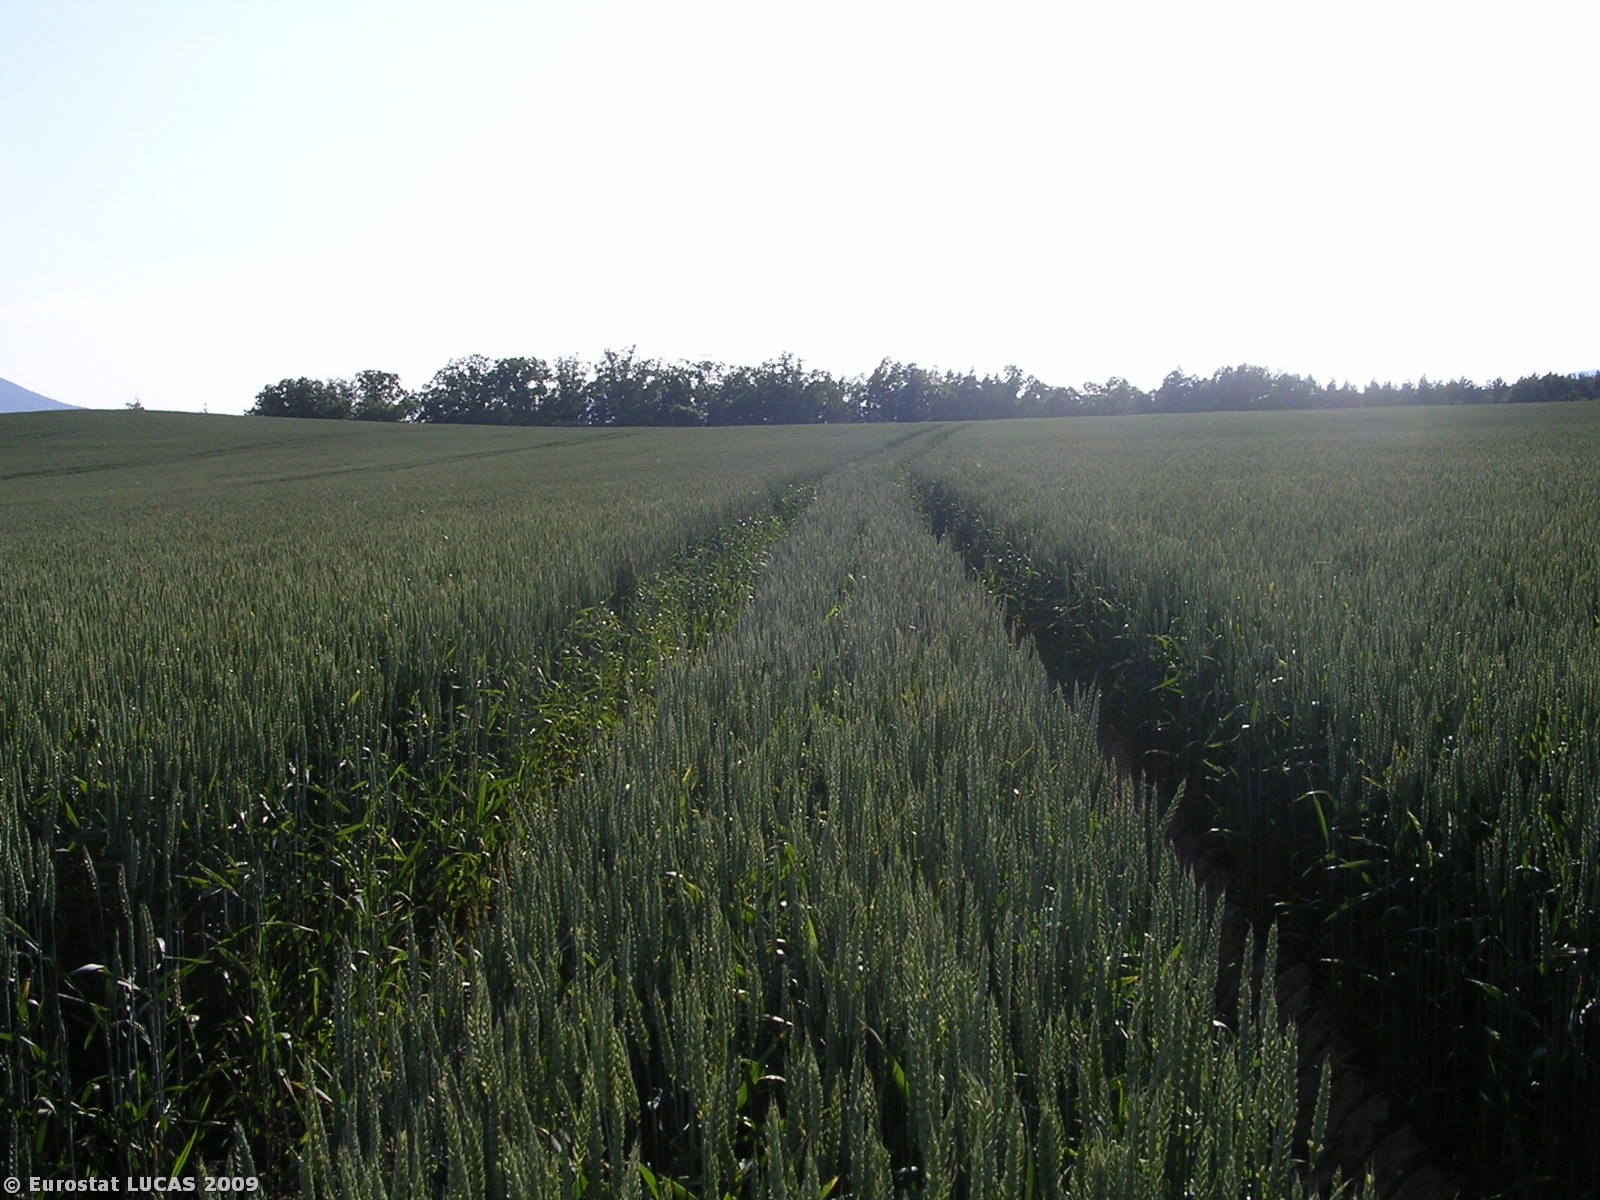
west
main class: Cropland
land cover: Common wheat
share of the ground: > 75 %
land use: Agriculture (excluding fallow land and kitchen gardens)
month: June
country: CZ
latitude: 50.6341
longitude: 14.5404
